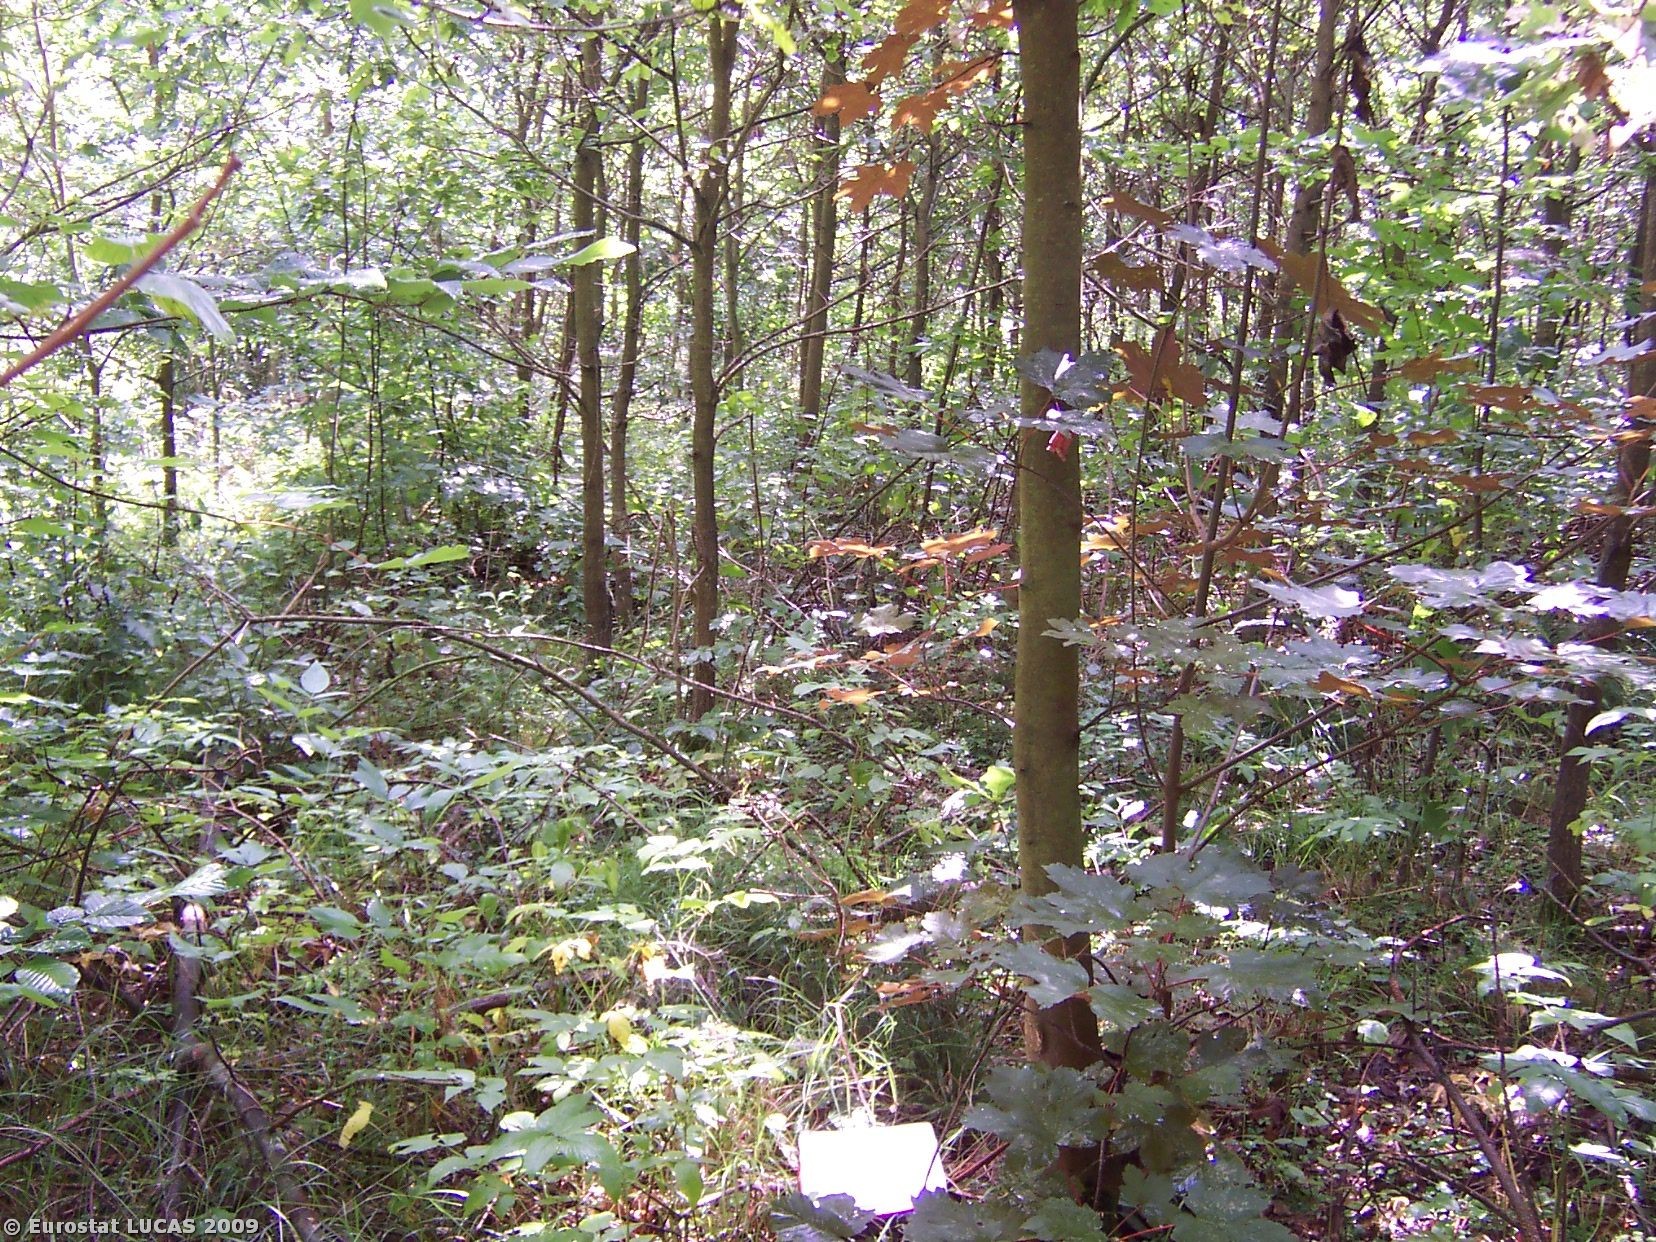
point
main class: Woodland
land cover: Broadleaved woodland
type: mesophytic deciduous forest
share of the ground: > 75 %
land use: Forestry
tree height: > 5 m
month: August
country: PL
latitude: 52.8118
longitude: 21.1583
